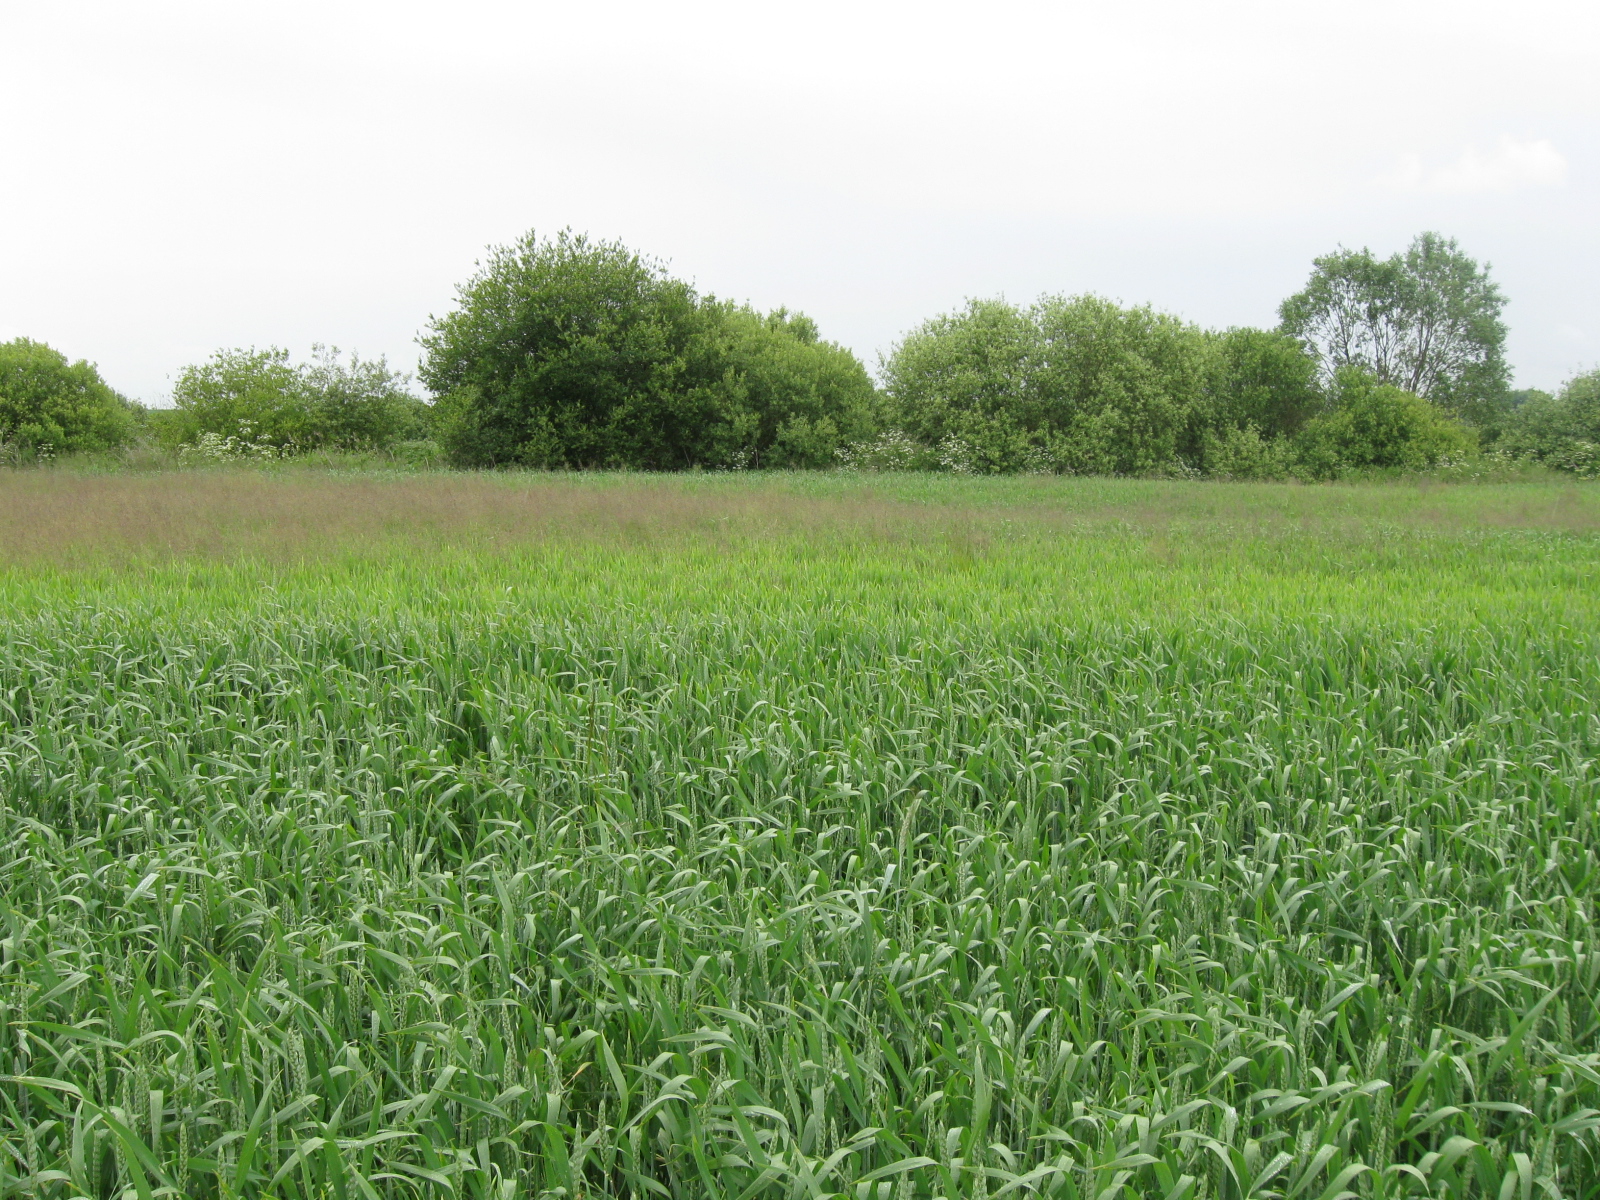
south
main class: Cropland
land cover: Common wheat
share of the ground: > 75 %
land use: Agriculture (excluding fallow land and kitchen gardens)
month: June
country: LT
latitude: 54.9113
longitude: 24.5633
